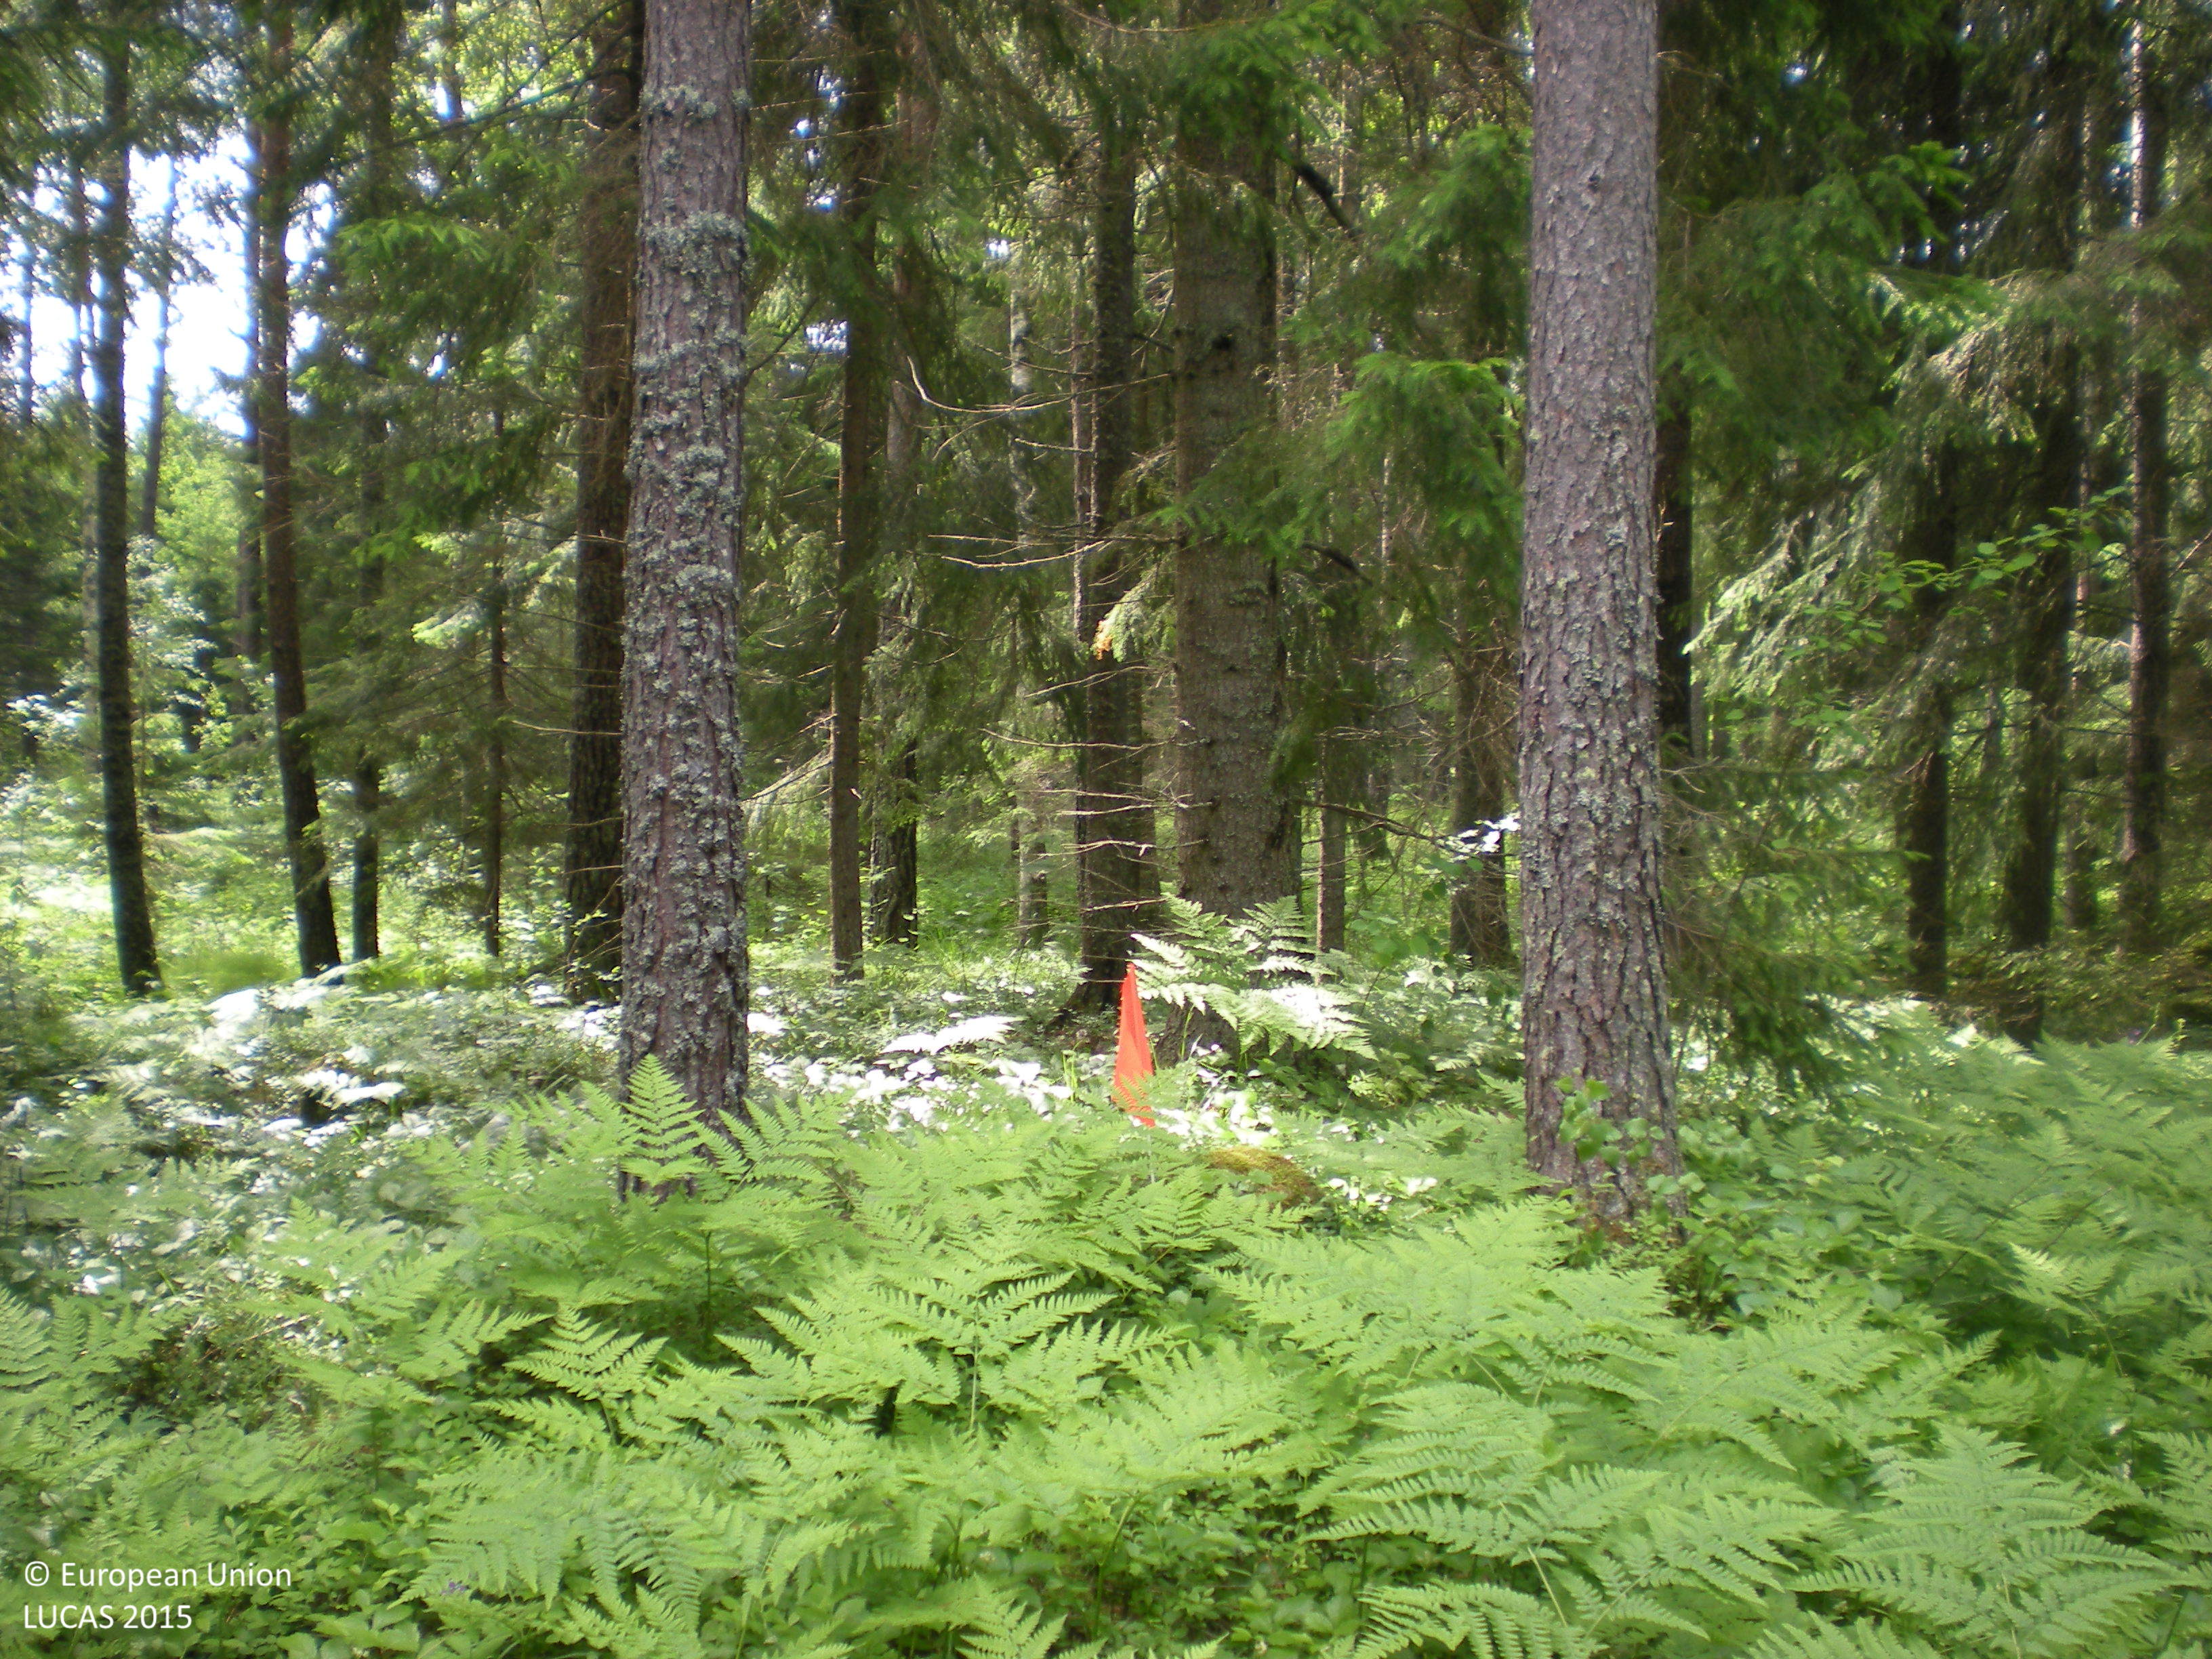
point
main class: Woodland
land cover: Spruce dominated coniferous woodland
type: boreal forest
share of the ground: 50 - 75 %
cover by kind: coniferous forest trees 60 %, herbaceous plants 20 %, broadleaved forest trees 10 %, shrubs 10 %
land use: Forestry
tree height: > 5 m
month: June
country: SE
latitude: 60.4181
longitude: 17.7828
